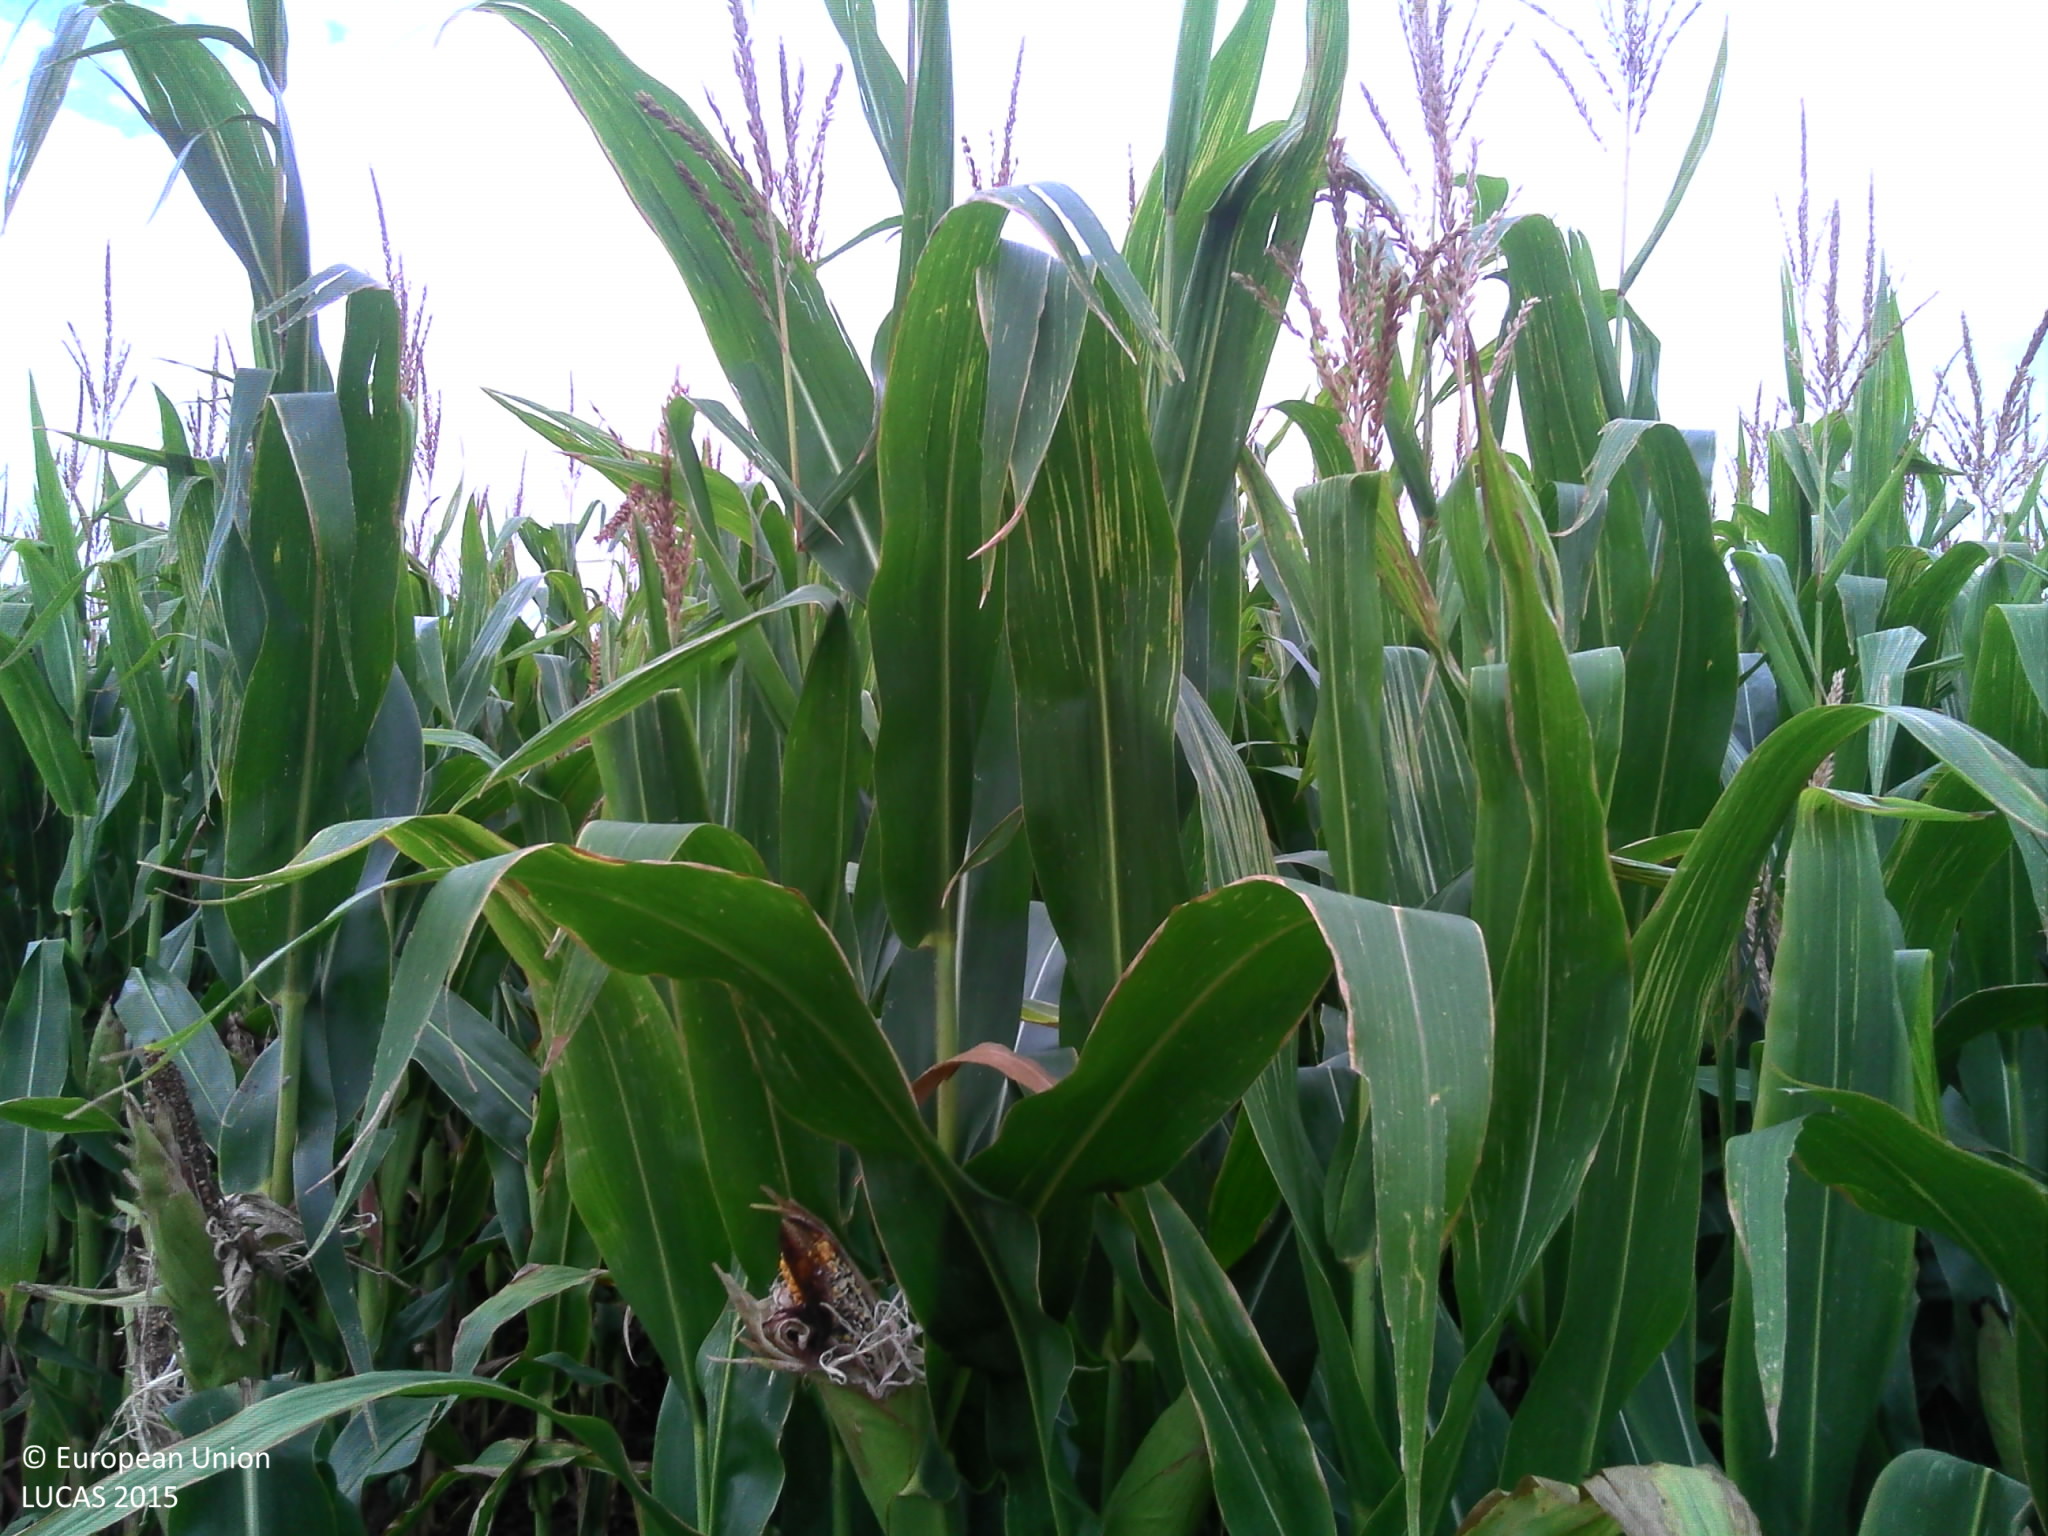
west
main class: Cropland
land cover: Maize
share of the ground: > 75 %
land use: Agriculture (excluding fallow land and kitchen gardens)
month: August
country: FR
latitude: 48.7019
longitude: 7.6229
